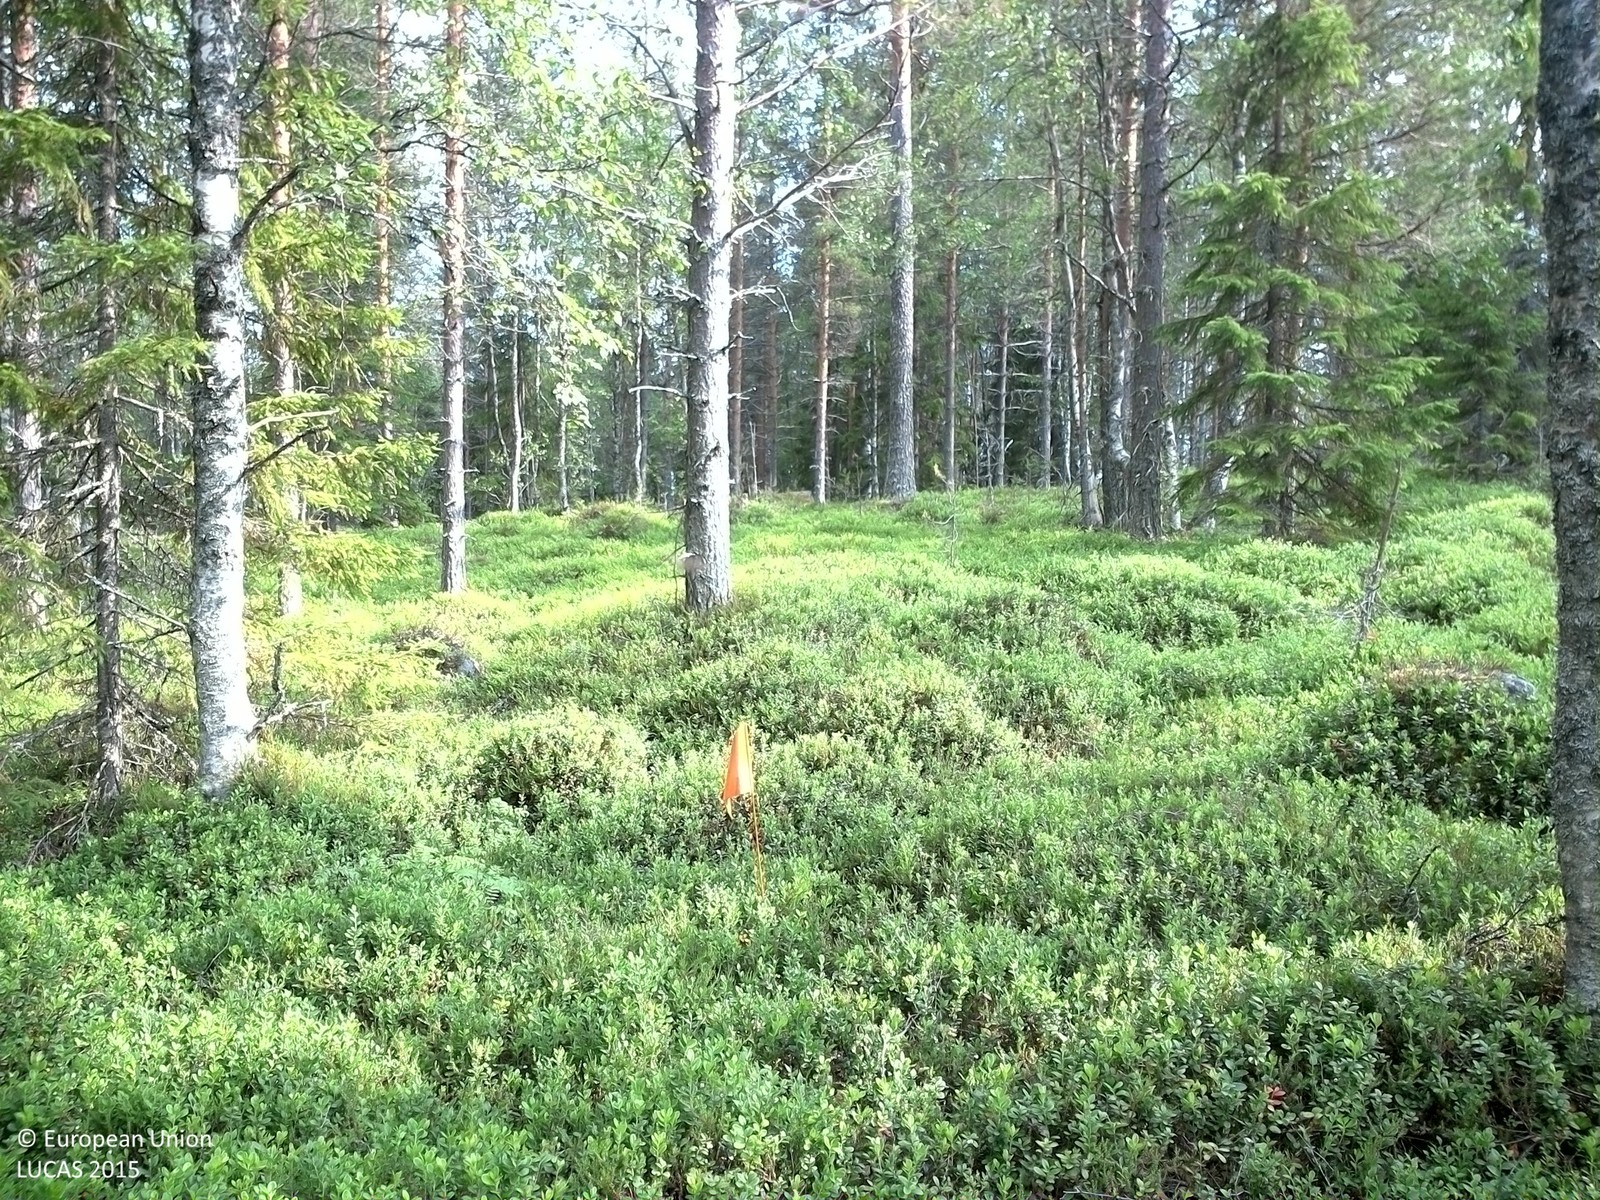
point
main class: Woodland
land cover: Pine dominated mixed woodland
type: boreal forest
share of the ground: 50 - 75 %
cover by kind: coniferous forest trees 45 %, shrubs 30 %, broadleaved forest trees 15 %, lichens and mosses 10 %
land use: Forestry
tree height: > 5 m
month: July
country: SE
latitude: 63.5401
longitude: 17.3159
